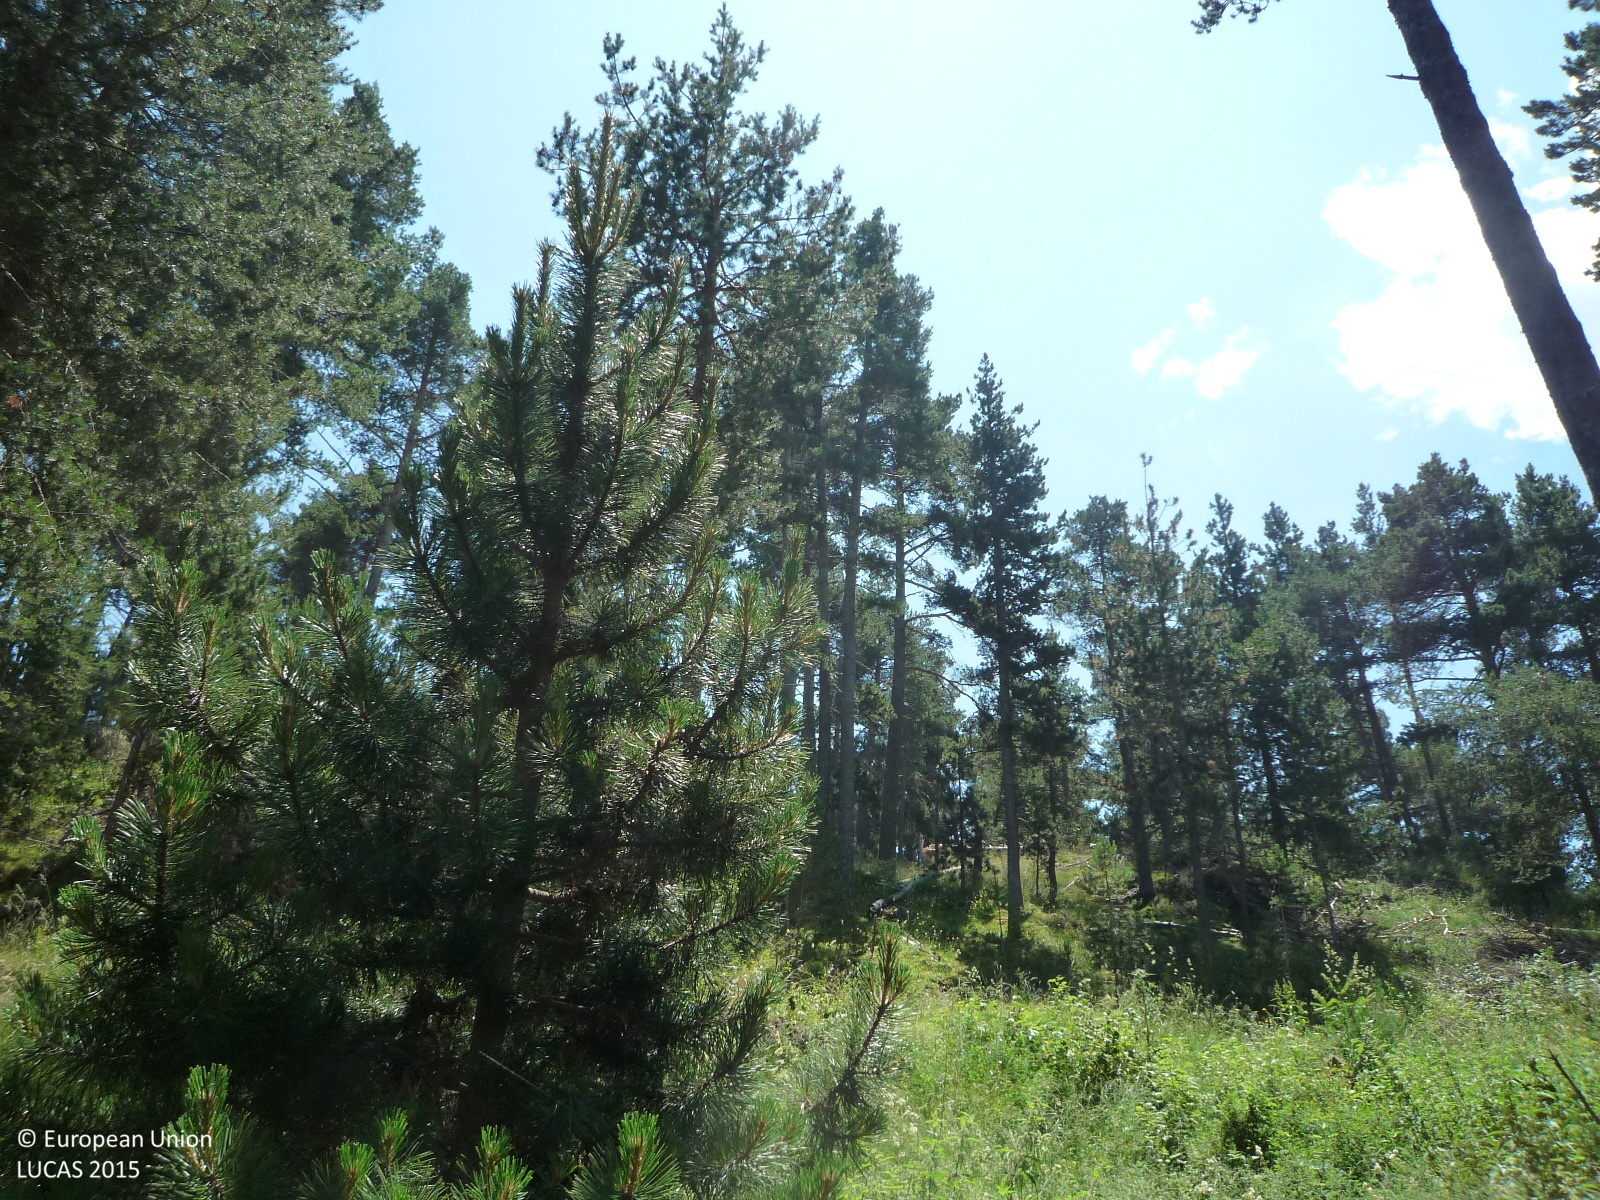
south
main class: Woodland
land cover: Pine dominated coniferous woodland
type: alpine coniferous forest
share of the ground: > 75 %
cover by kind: coniferous forest trees 90 %, herbaceous plants 10 %
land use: Forestry
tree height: > 5 m
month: June
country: ES
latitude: 42.3524
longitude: 1.9629
